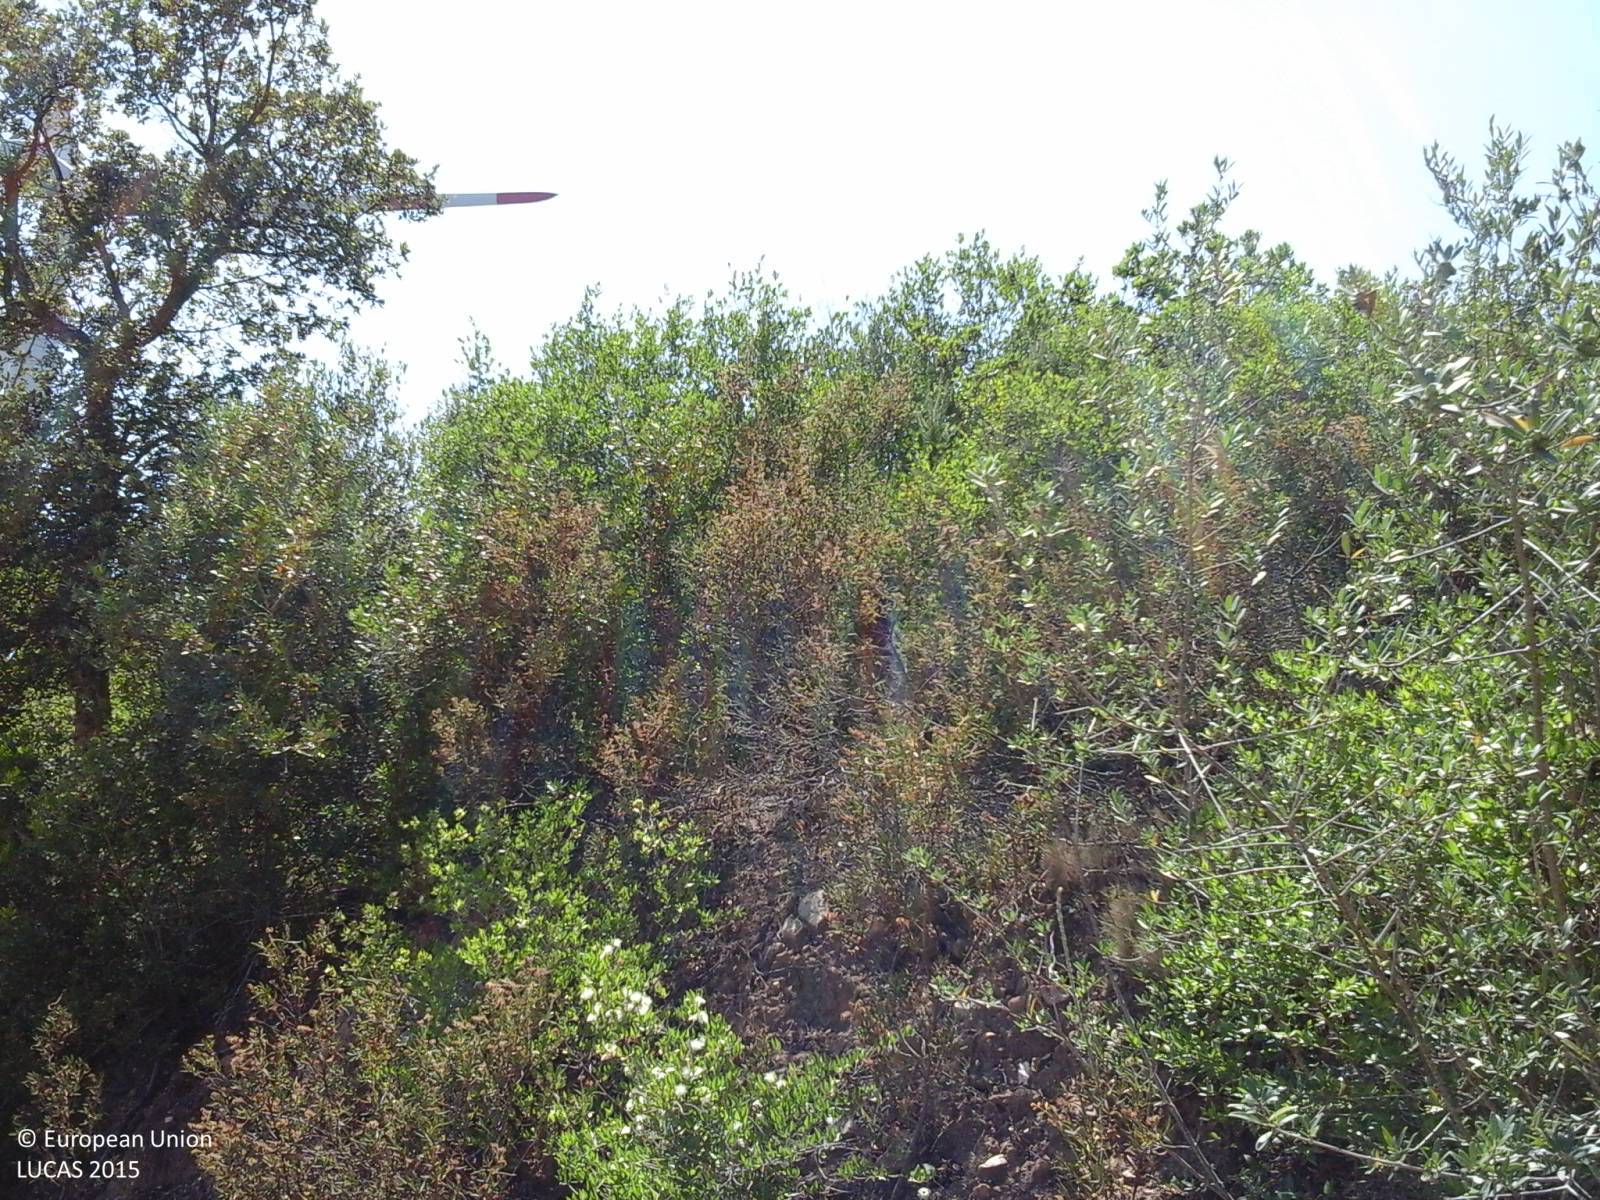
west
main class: Woodland
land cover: Broadleaved woodland
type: broadleaved evergreen forest
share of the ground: > 75 %
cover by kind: broadleaved forest trees 100 %
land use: Semi-natural and natural areas not in use
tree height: < 5 m
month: June
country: IT
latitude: 39.8984
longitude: 8.8485
